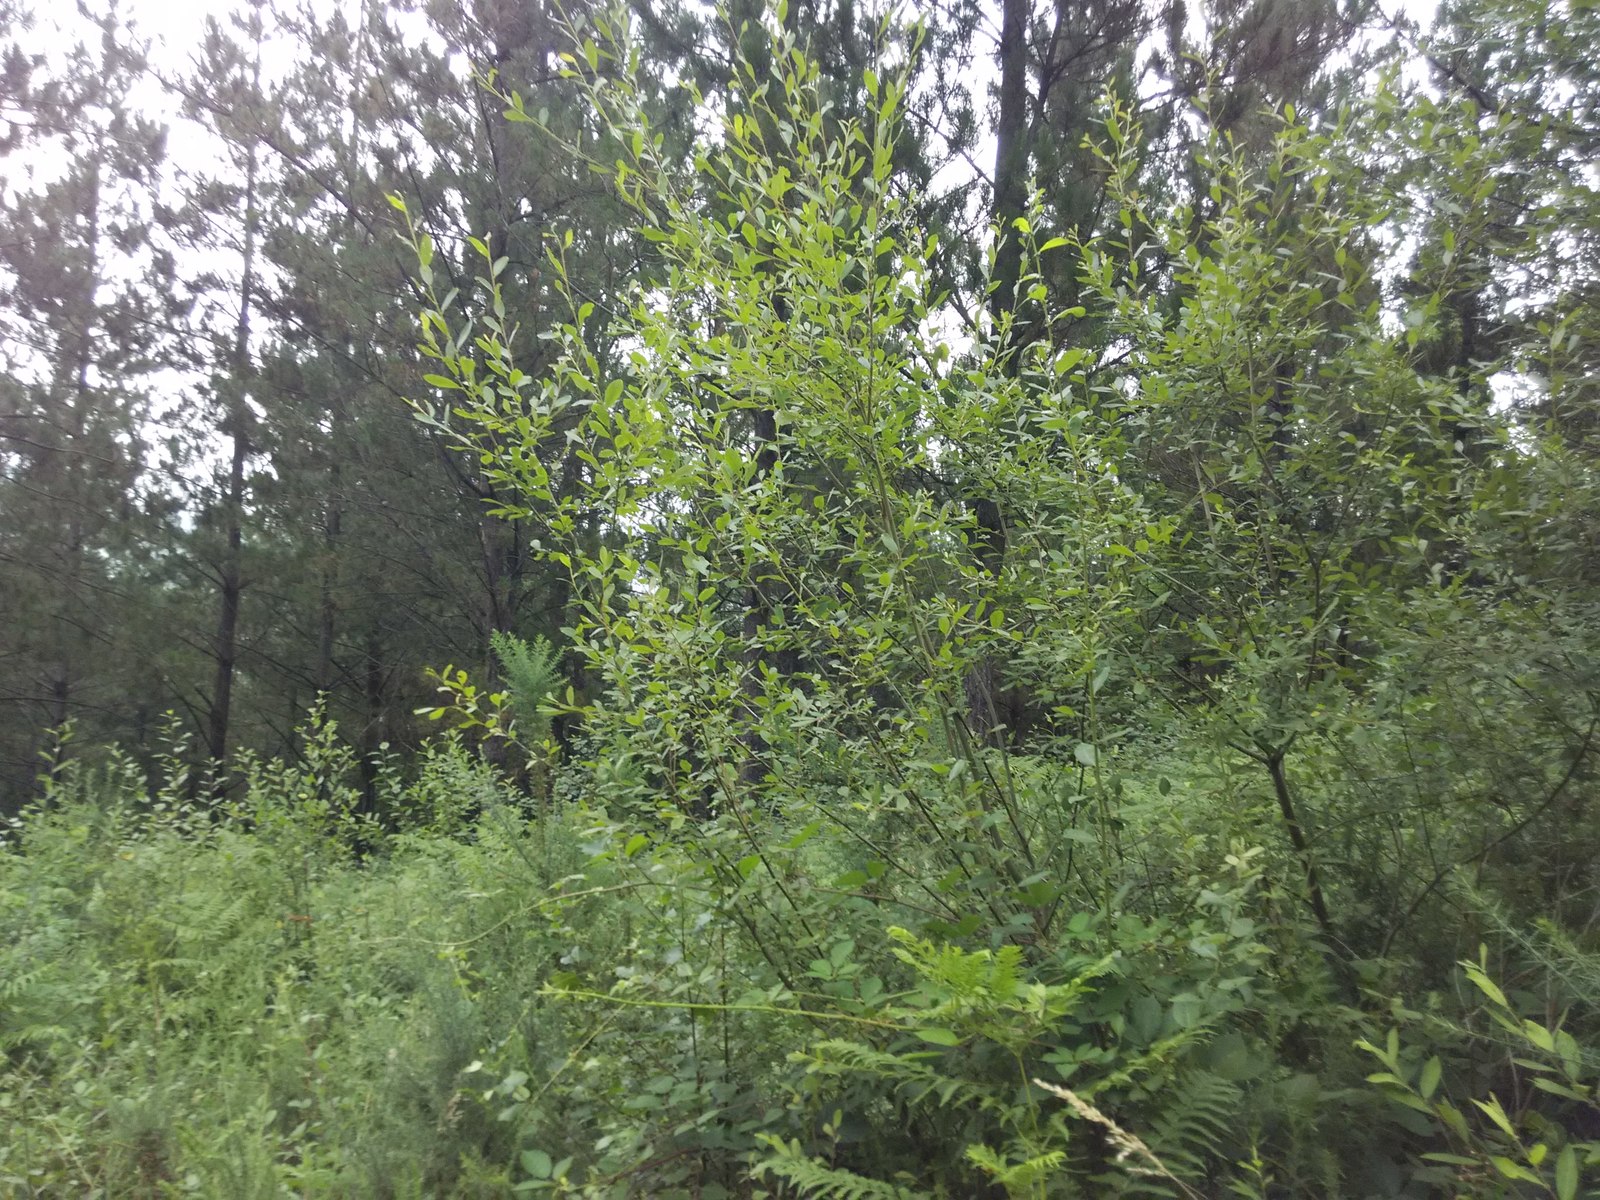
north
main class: Woodland
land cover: Pine dominated coniferous woodland
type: exotic forest
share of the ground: > 75 %
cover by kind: coniferous forest trees 90 %, shrubs 10 %
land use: Forestry
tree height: > 5 m
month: July
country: ES
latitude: 43.0400
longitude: -2.2365
